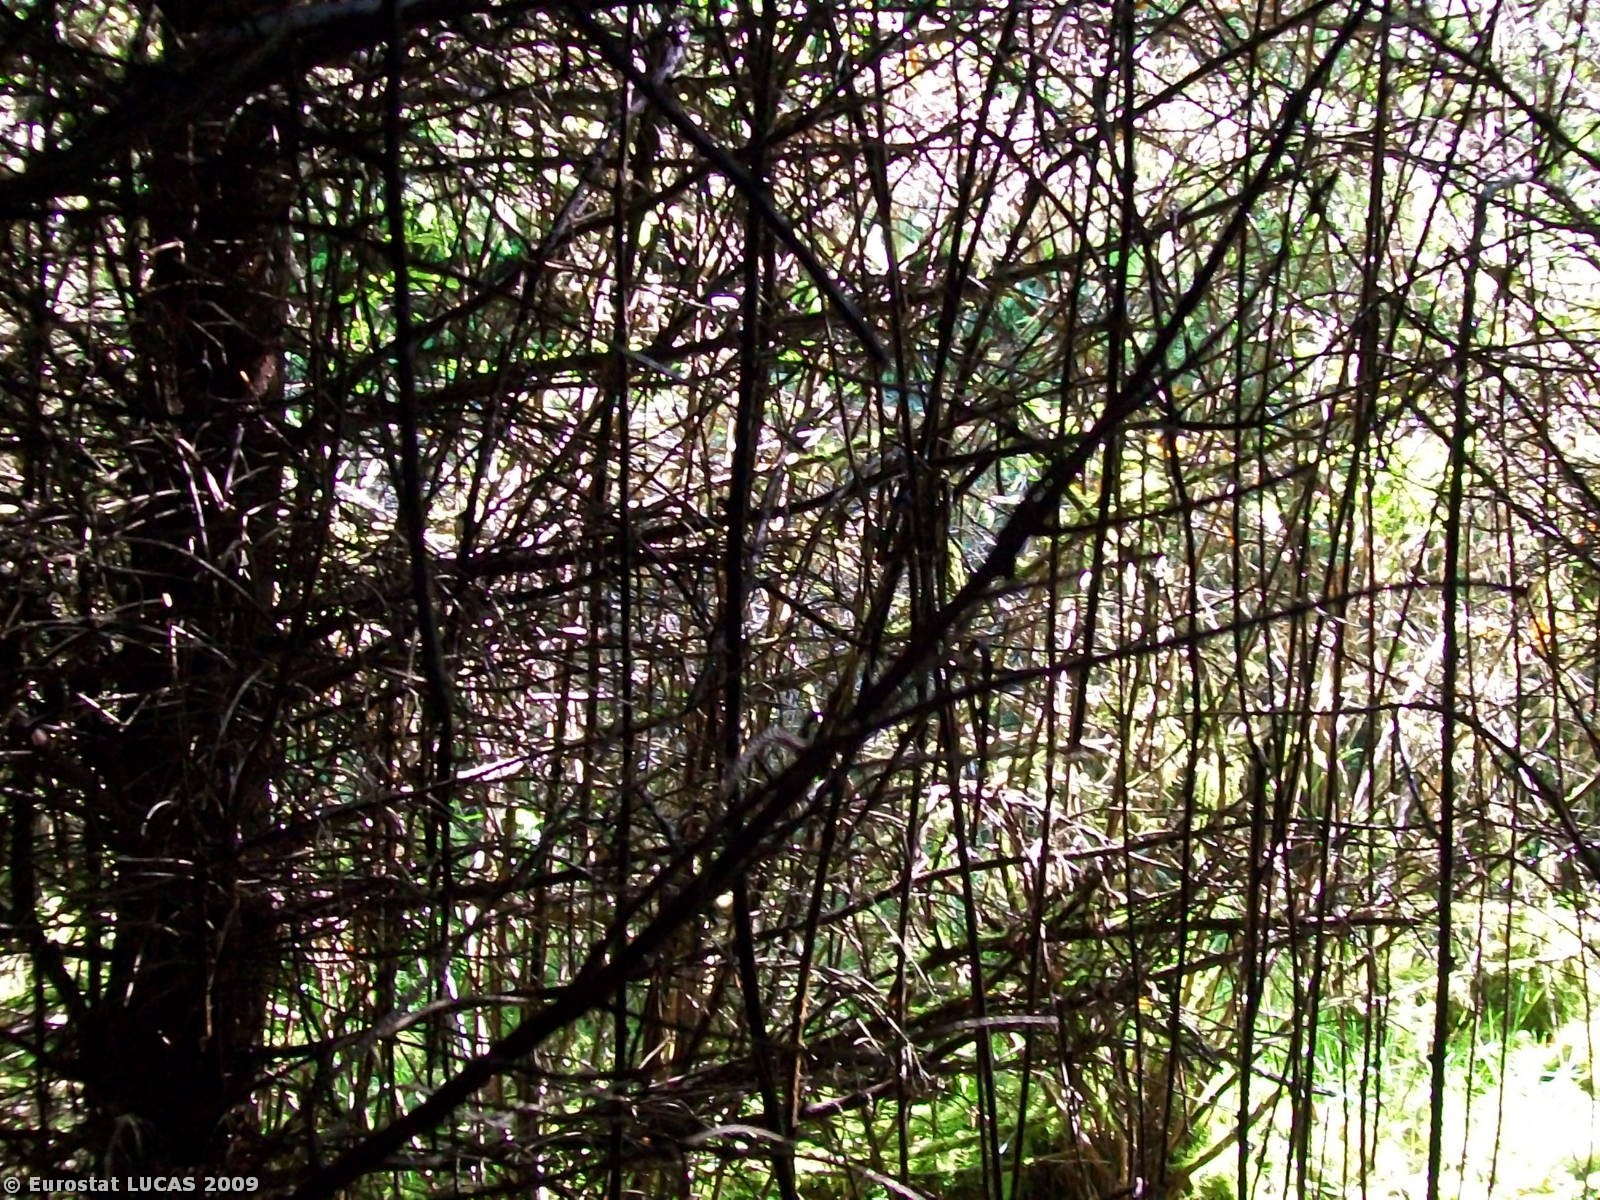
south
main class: Woodland
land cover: Coniferous woodland
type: plantations and self-sown exotic forest
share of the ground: > 75 %
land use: Forestry
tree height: > 5 m
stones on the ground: < 10 %
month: May
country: IE
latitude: 51.8356
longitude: -8.7957
